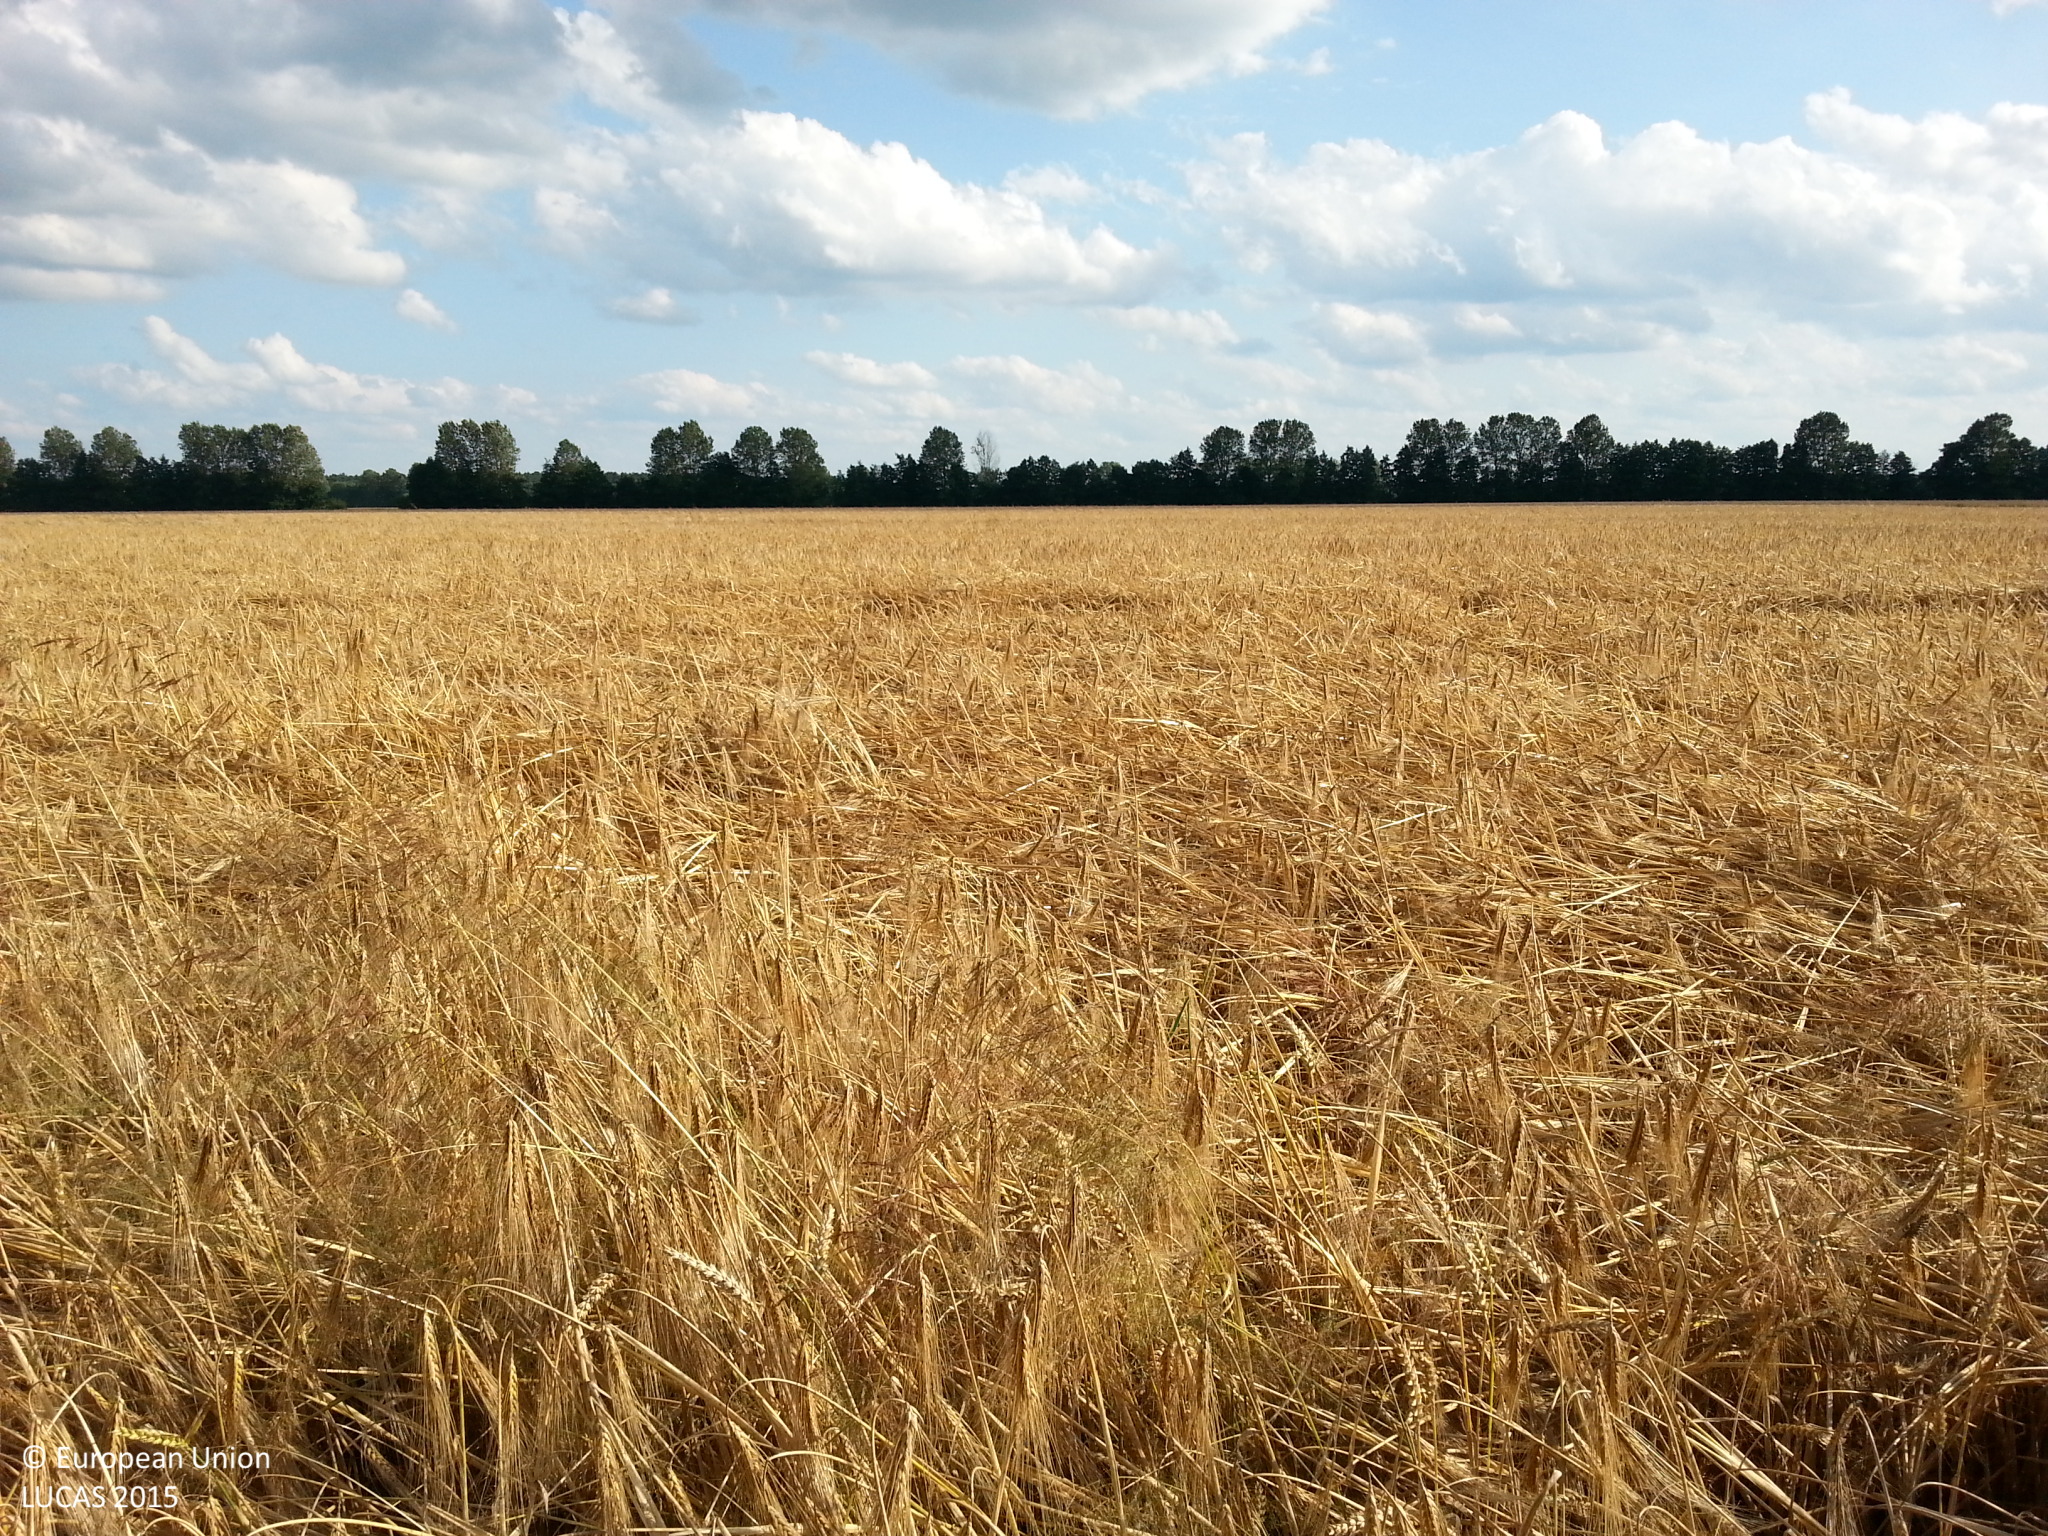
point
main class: Cropland
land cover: Barley
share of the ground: > 75 %
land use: Agriculture (excluding fallow land and kitchen gardens)
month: July
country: DE
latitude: 53.2167
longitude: 11.1526
